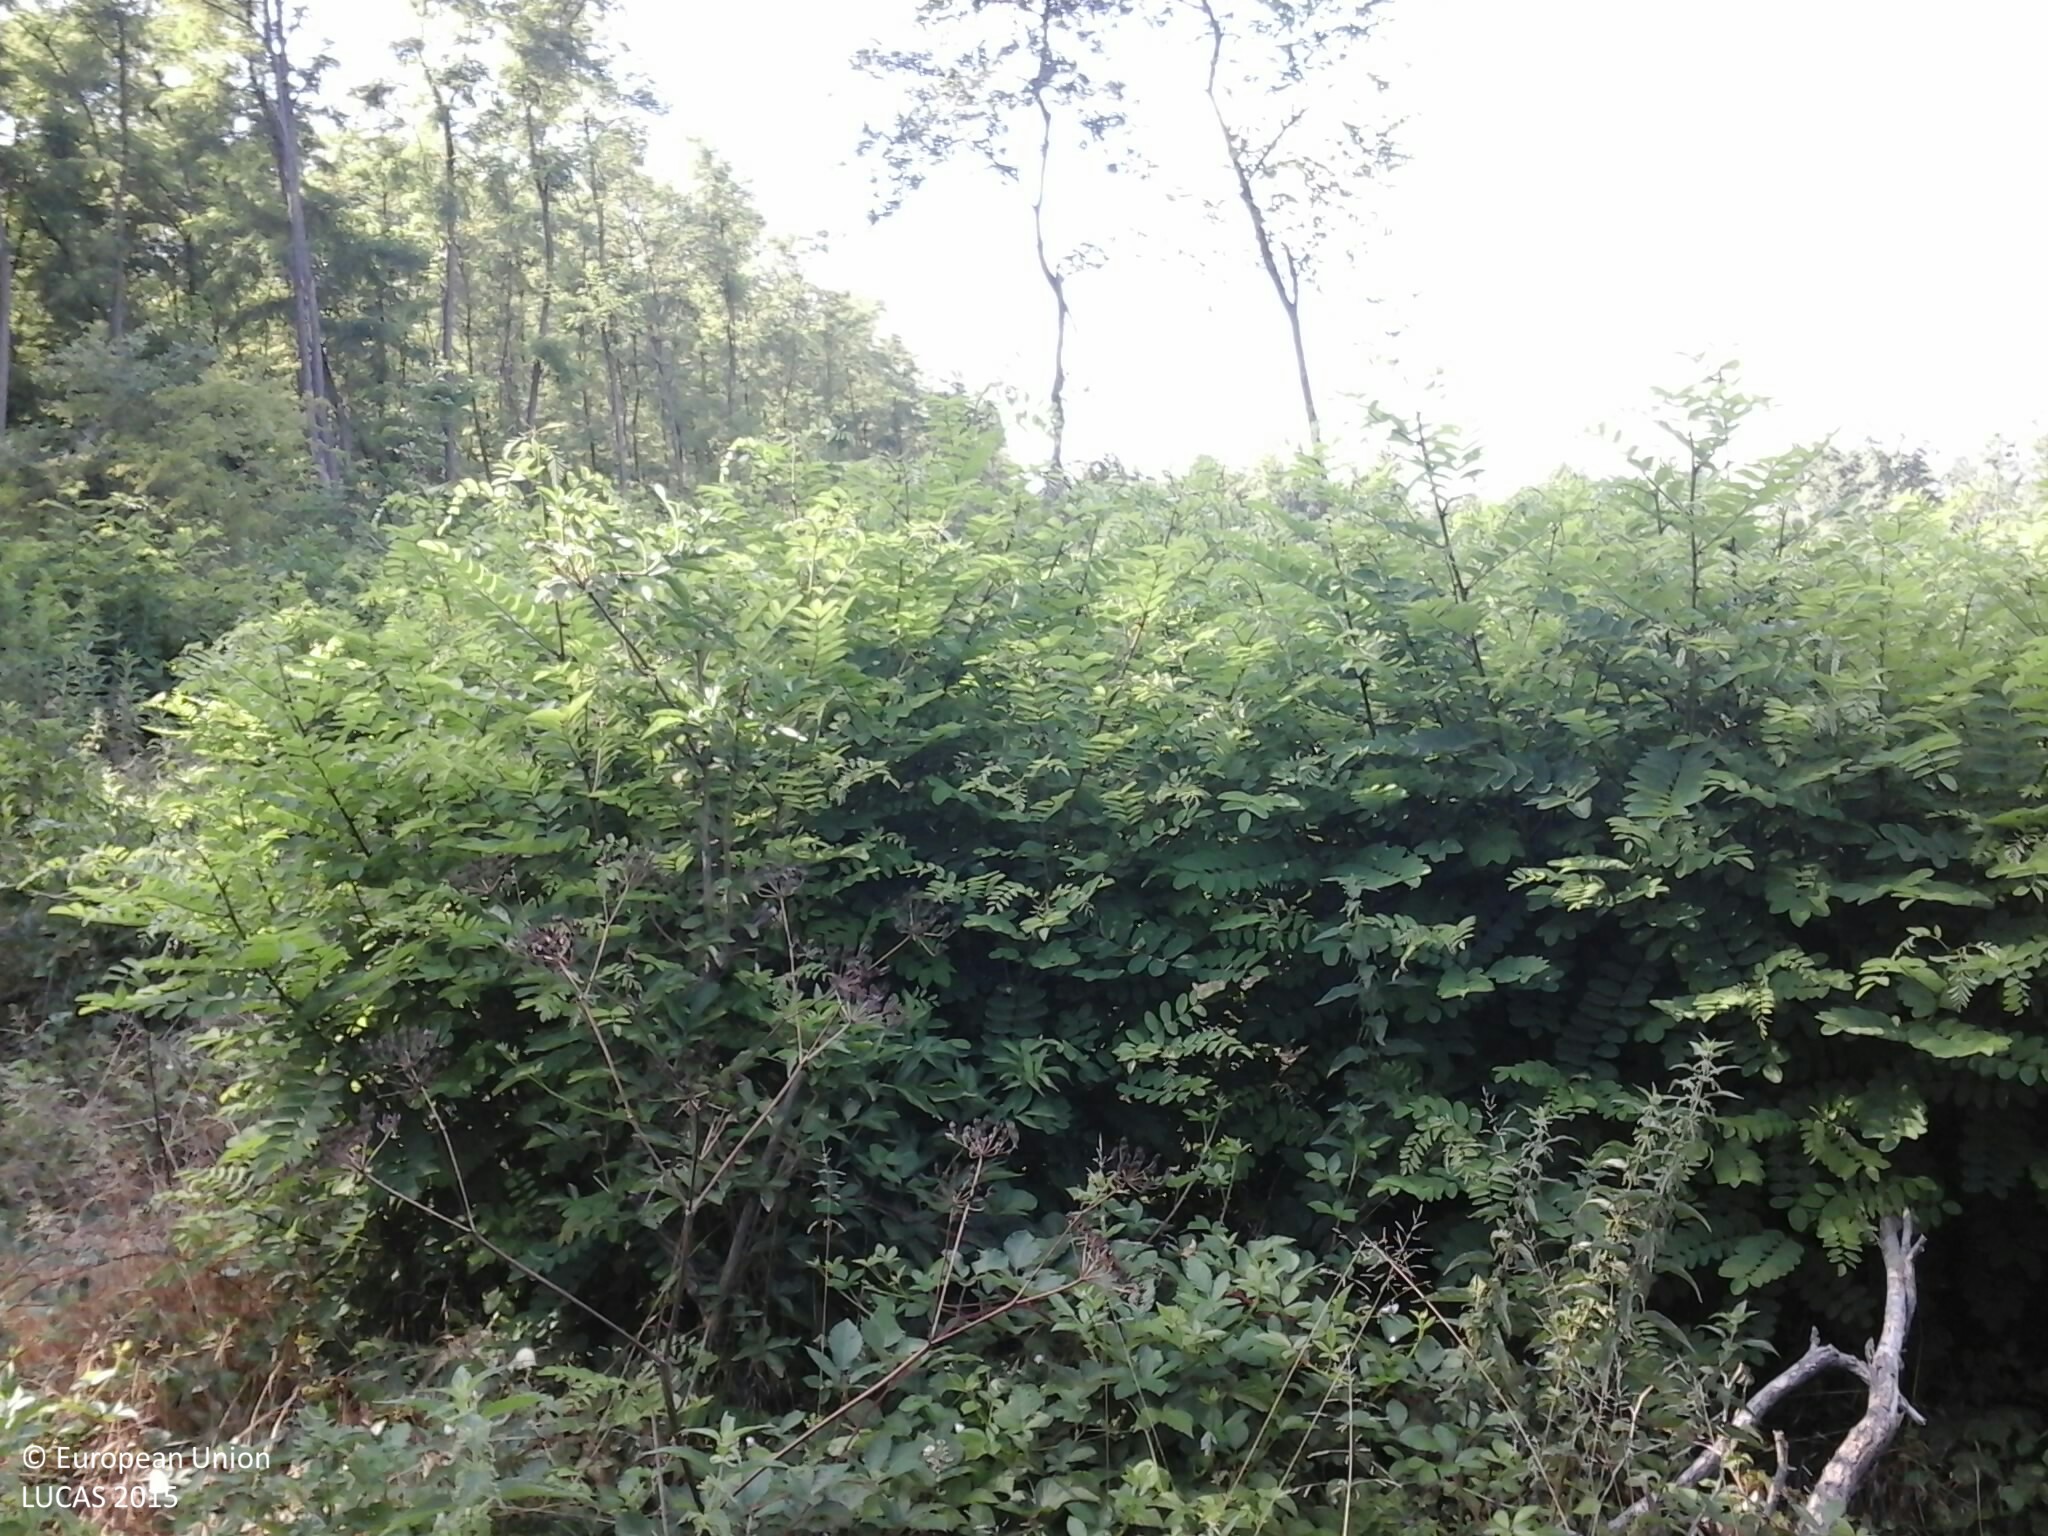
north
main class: Woodland
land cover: Broadleaved woodland
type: exotic forest
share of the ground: > 75 %
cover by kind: broadleaved forest trees 75 %, herbaceous plants 15 %, shrubs 10 %
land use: Forestry
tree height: > 5 m
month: July
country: HU
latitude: 46.9747
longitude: 17.2218
